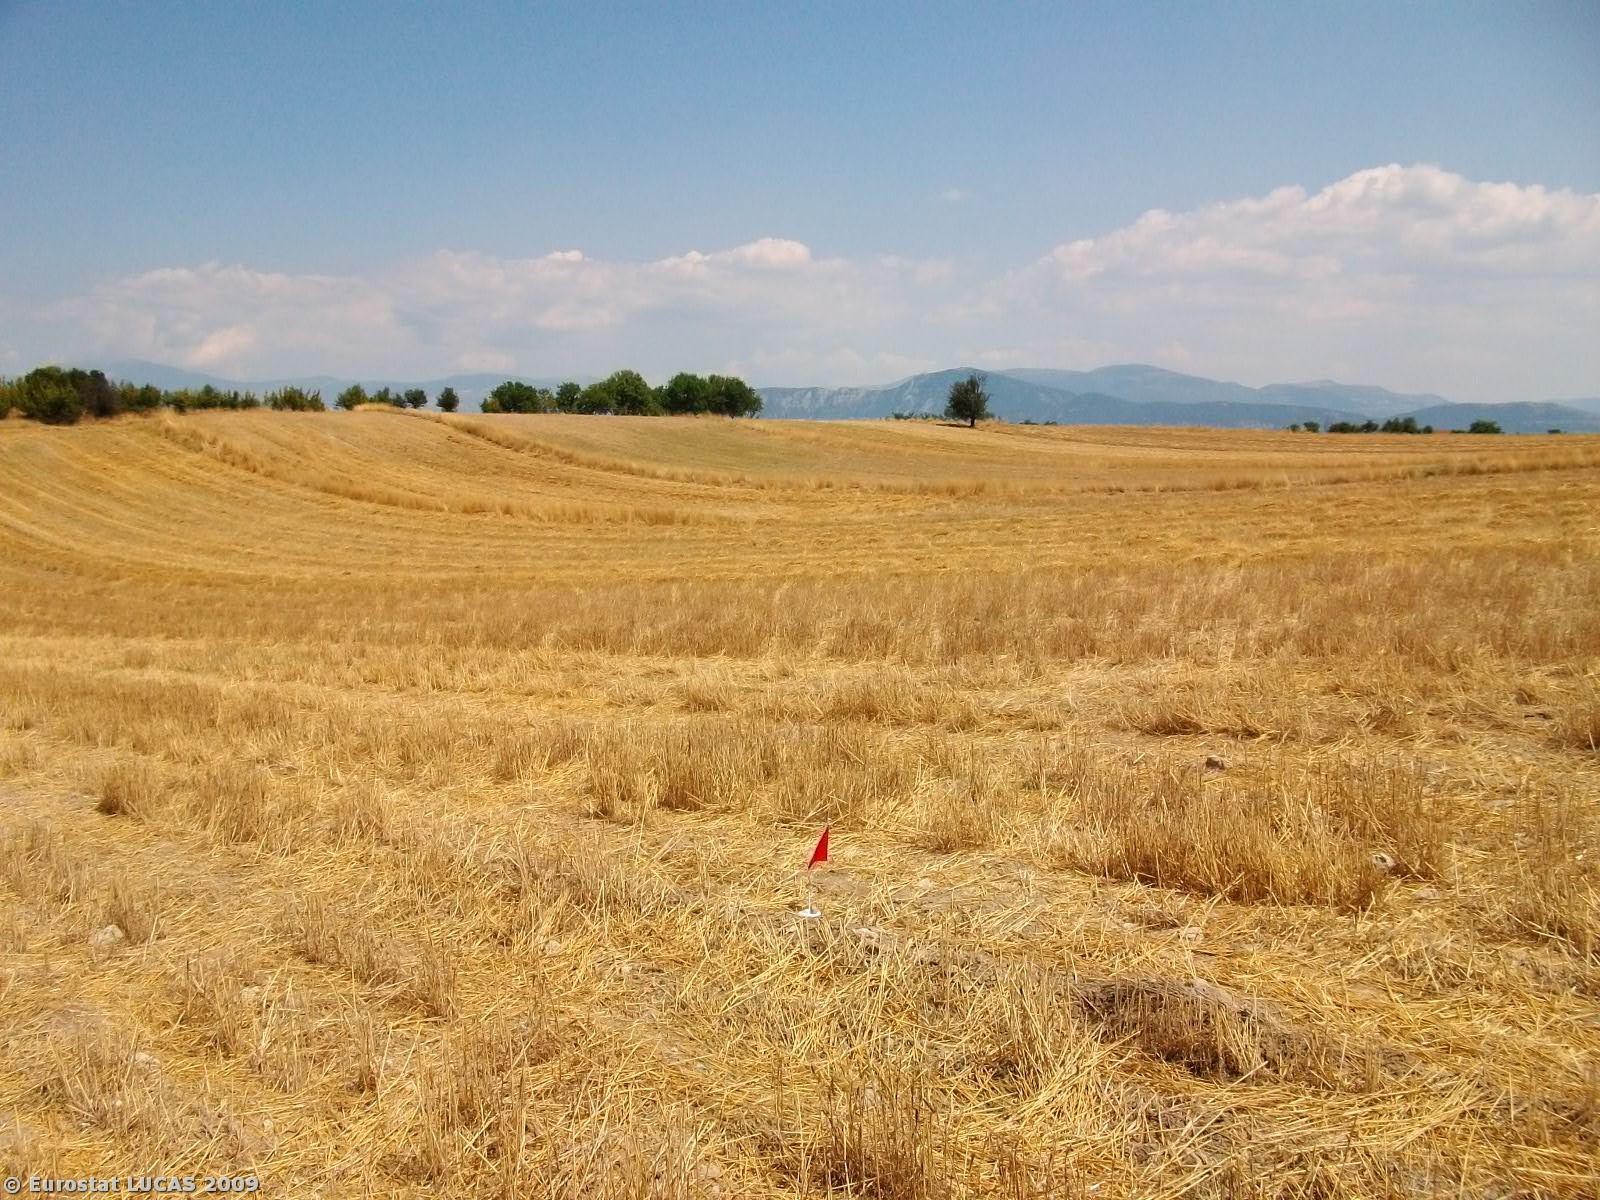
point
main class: Cropland
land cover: Durum wheat
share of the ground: < 10 %
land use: Agriculture (excluding fallow land and kitchen gardens)
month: July
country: GR
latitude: 40.1717
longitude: 21.8156
